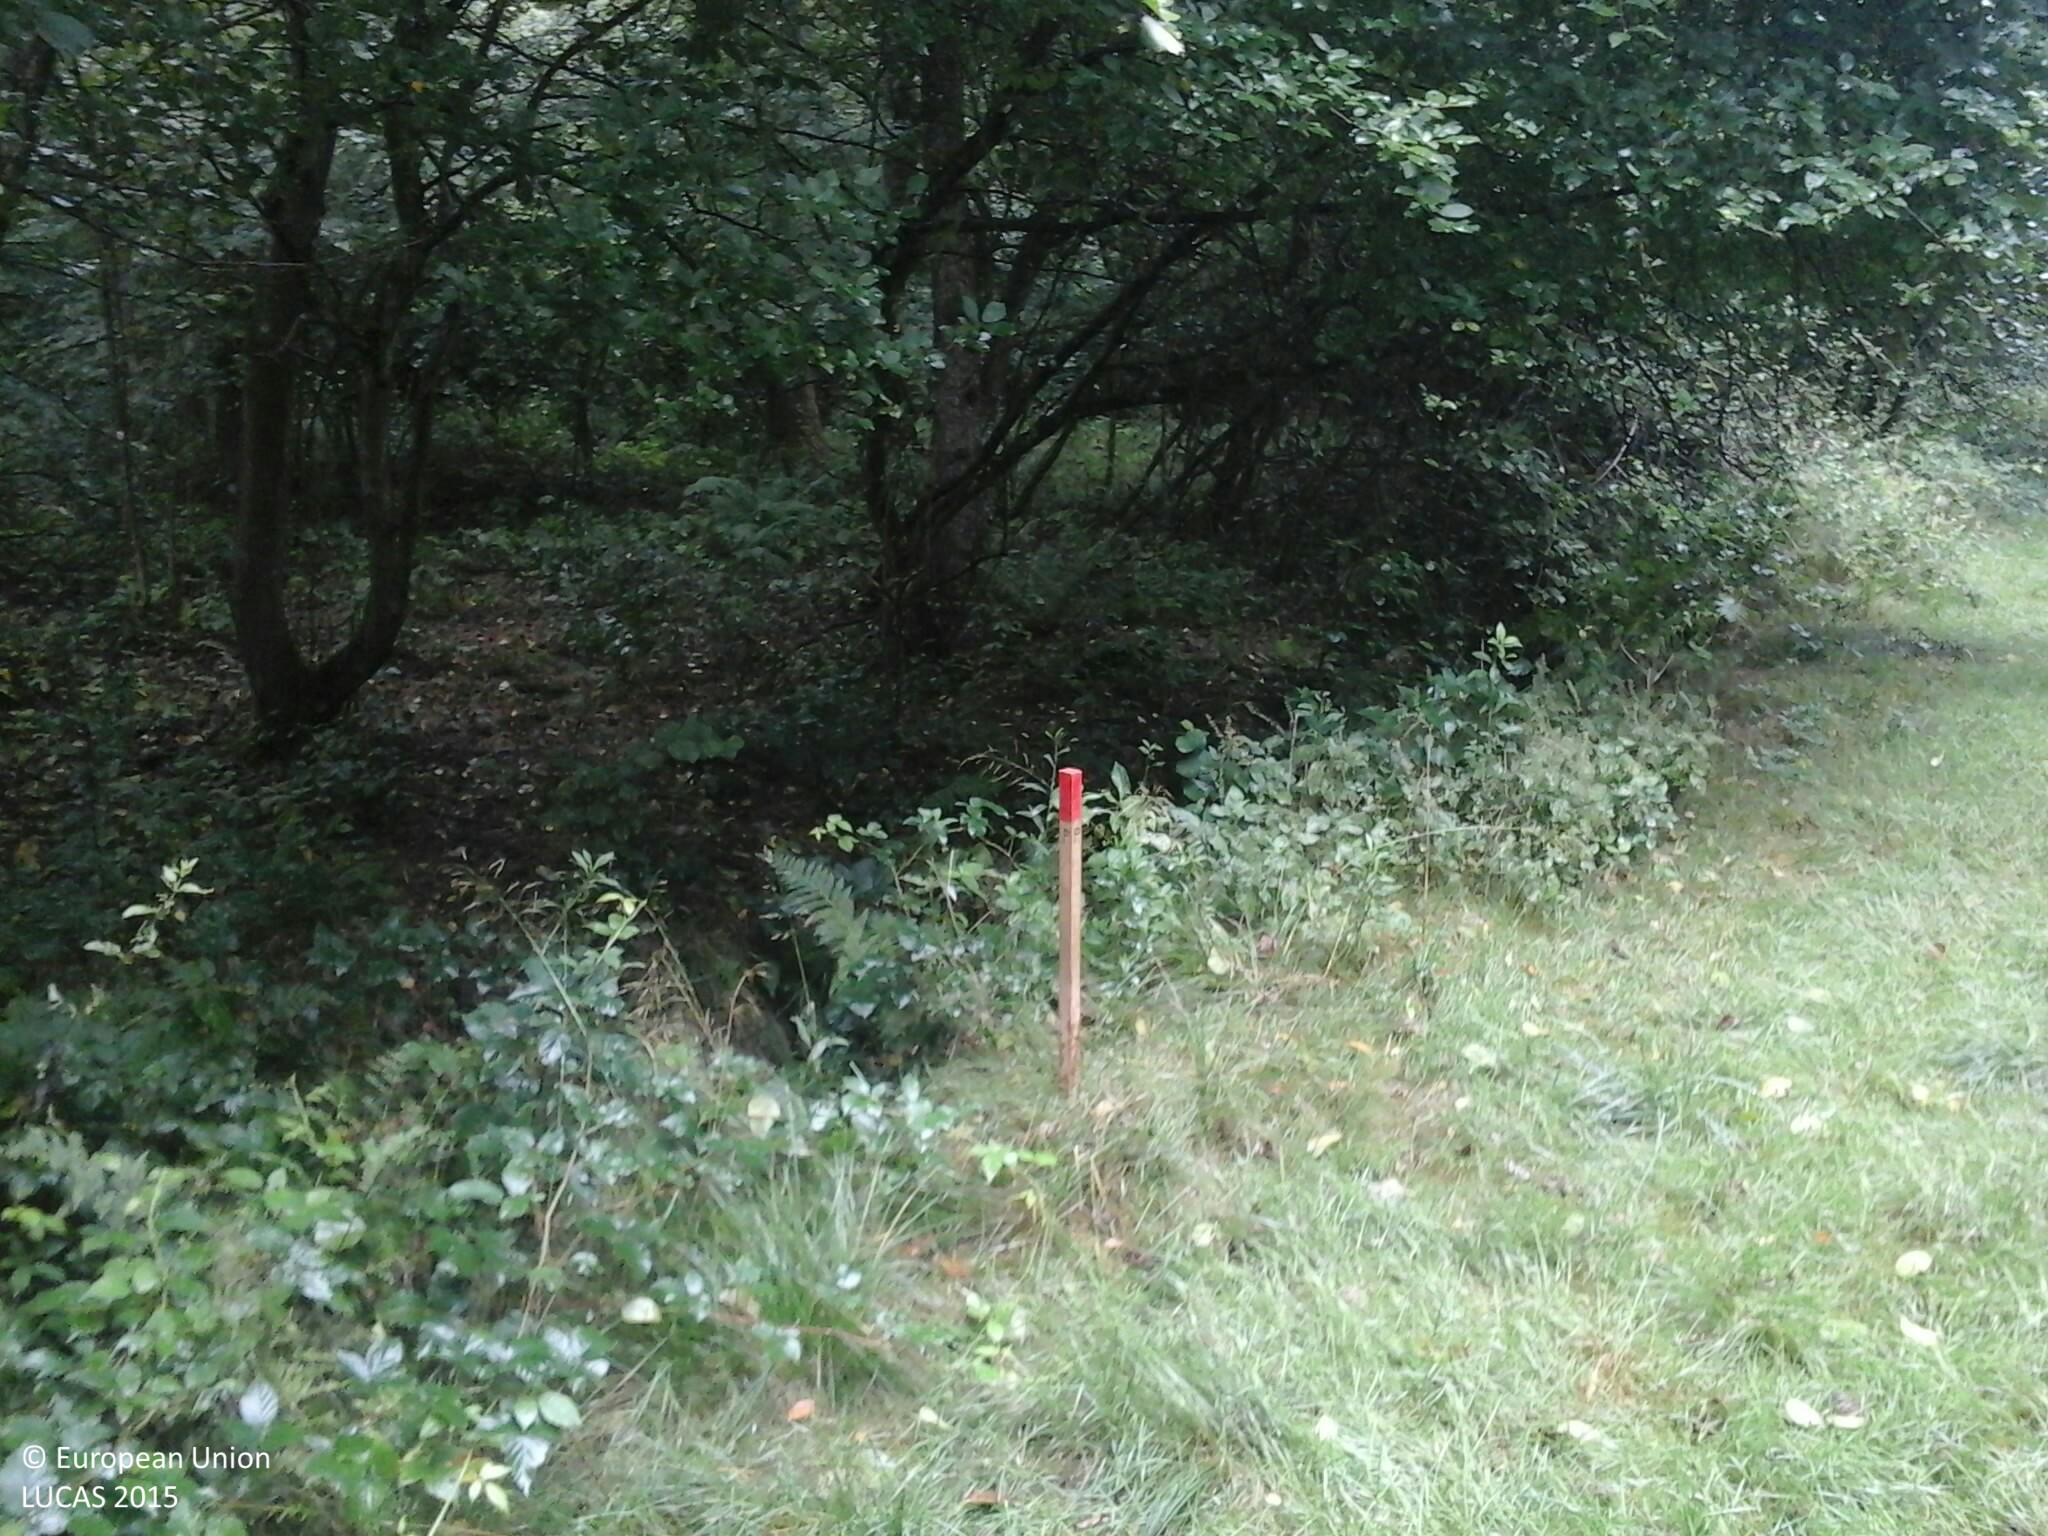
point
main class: Woodland
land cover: Broadleaved woodland
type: mesophytic deciduous forest
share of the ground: > 75 %
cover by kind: broadleaved forest trees 75 %, herbaceous plants 15 %, shrubs 10 %
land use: Forestry
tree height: > 5 m
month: July
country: HU
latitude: 46.9121
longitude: 16.5015
